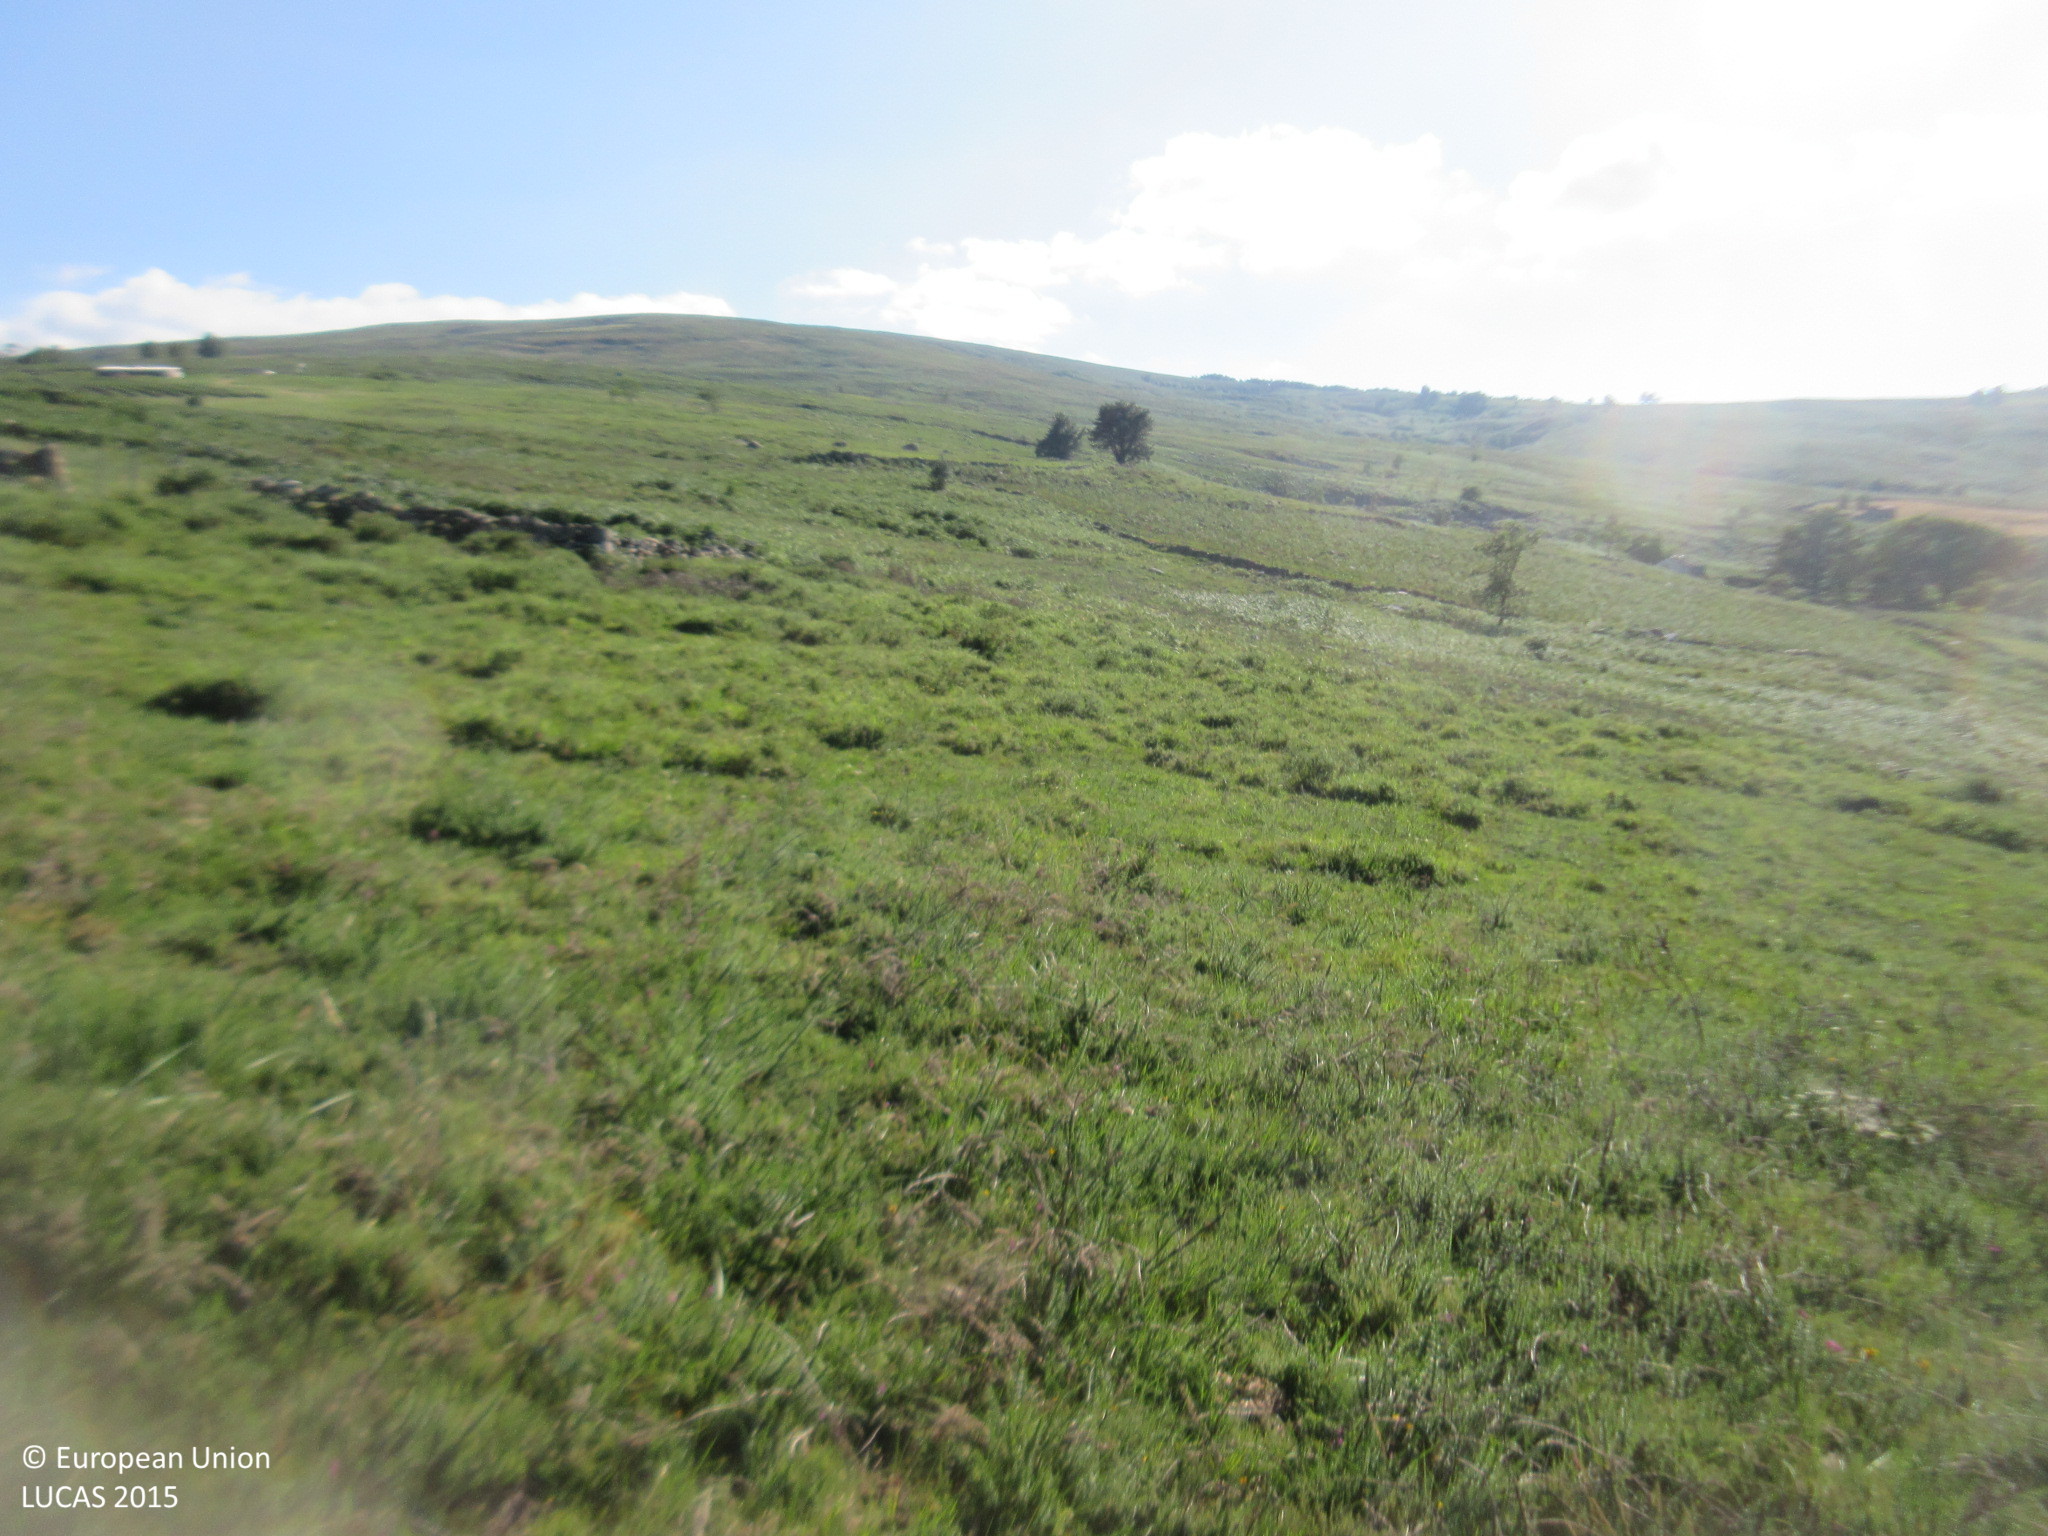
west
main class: Shrubland
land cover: Shrubland without tree cover
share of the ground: > 75 %
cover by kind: shrubs 100 %
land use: Agriculture (excluding fallow land and kitchen gardens)
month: July
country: ES
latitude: 43.1318
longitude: -3.9268
